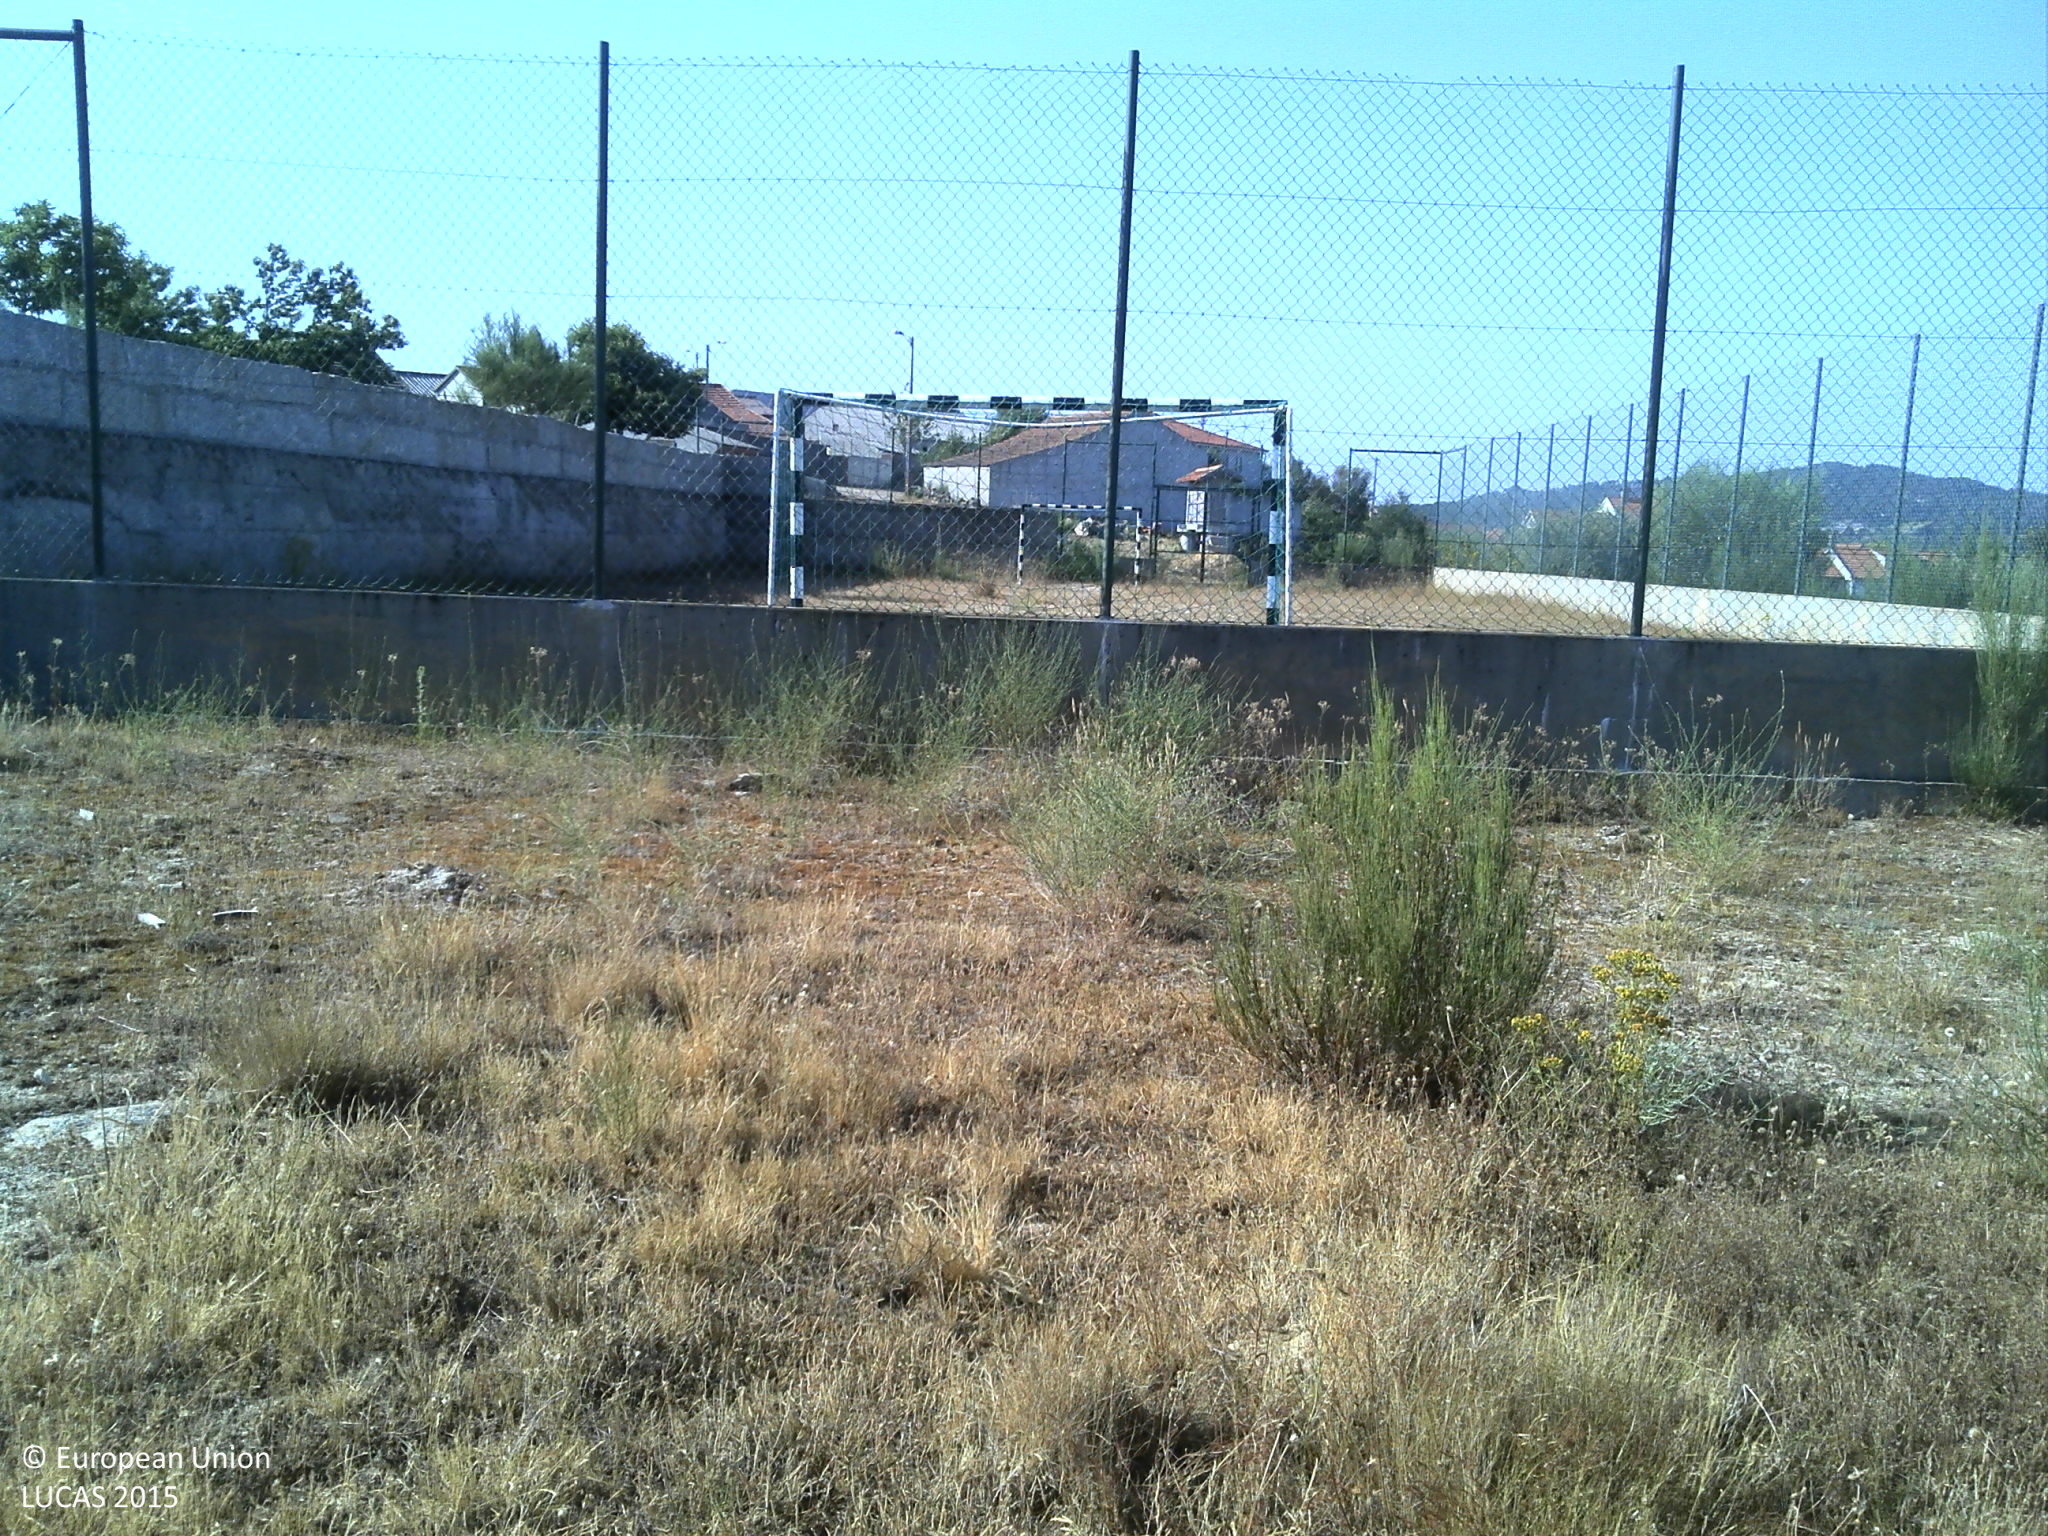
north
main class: Grassland
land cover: Grassland without tree/shrub cover
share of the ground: > 75 %
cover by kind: herbaceous plants 75 %, unconsolidated bare surface 20 %, shrubs 5 %
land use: Agriculture (excluding fallow land and kitchen gardens)
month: July
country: PT
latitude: 41.7135
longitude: -7.7697
